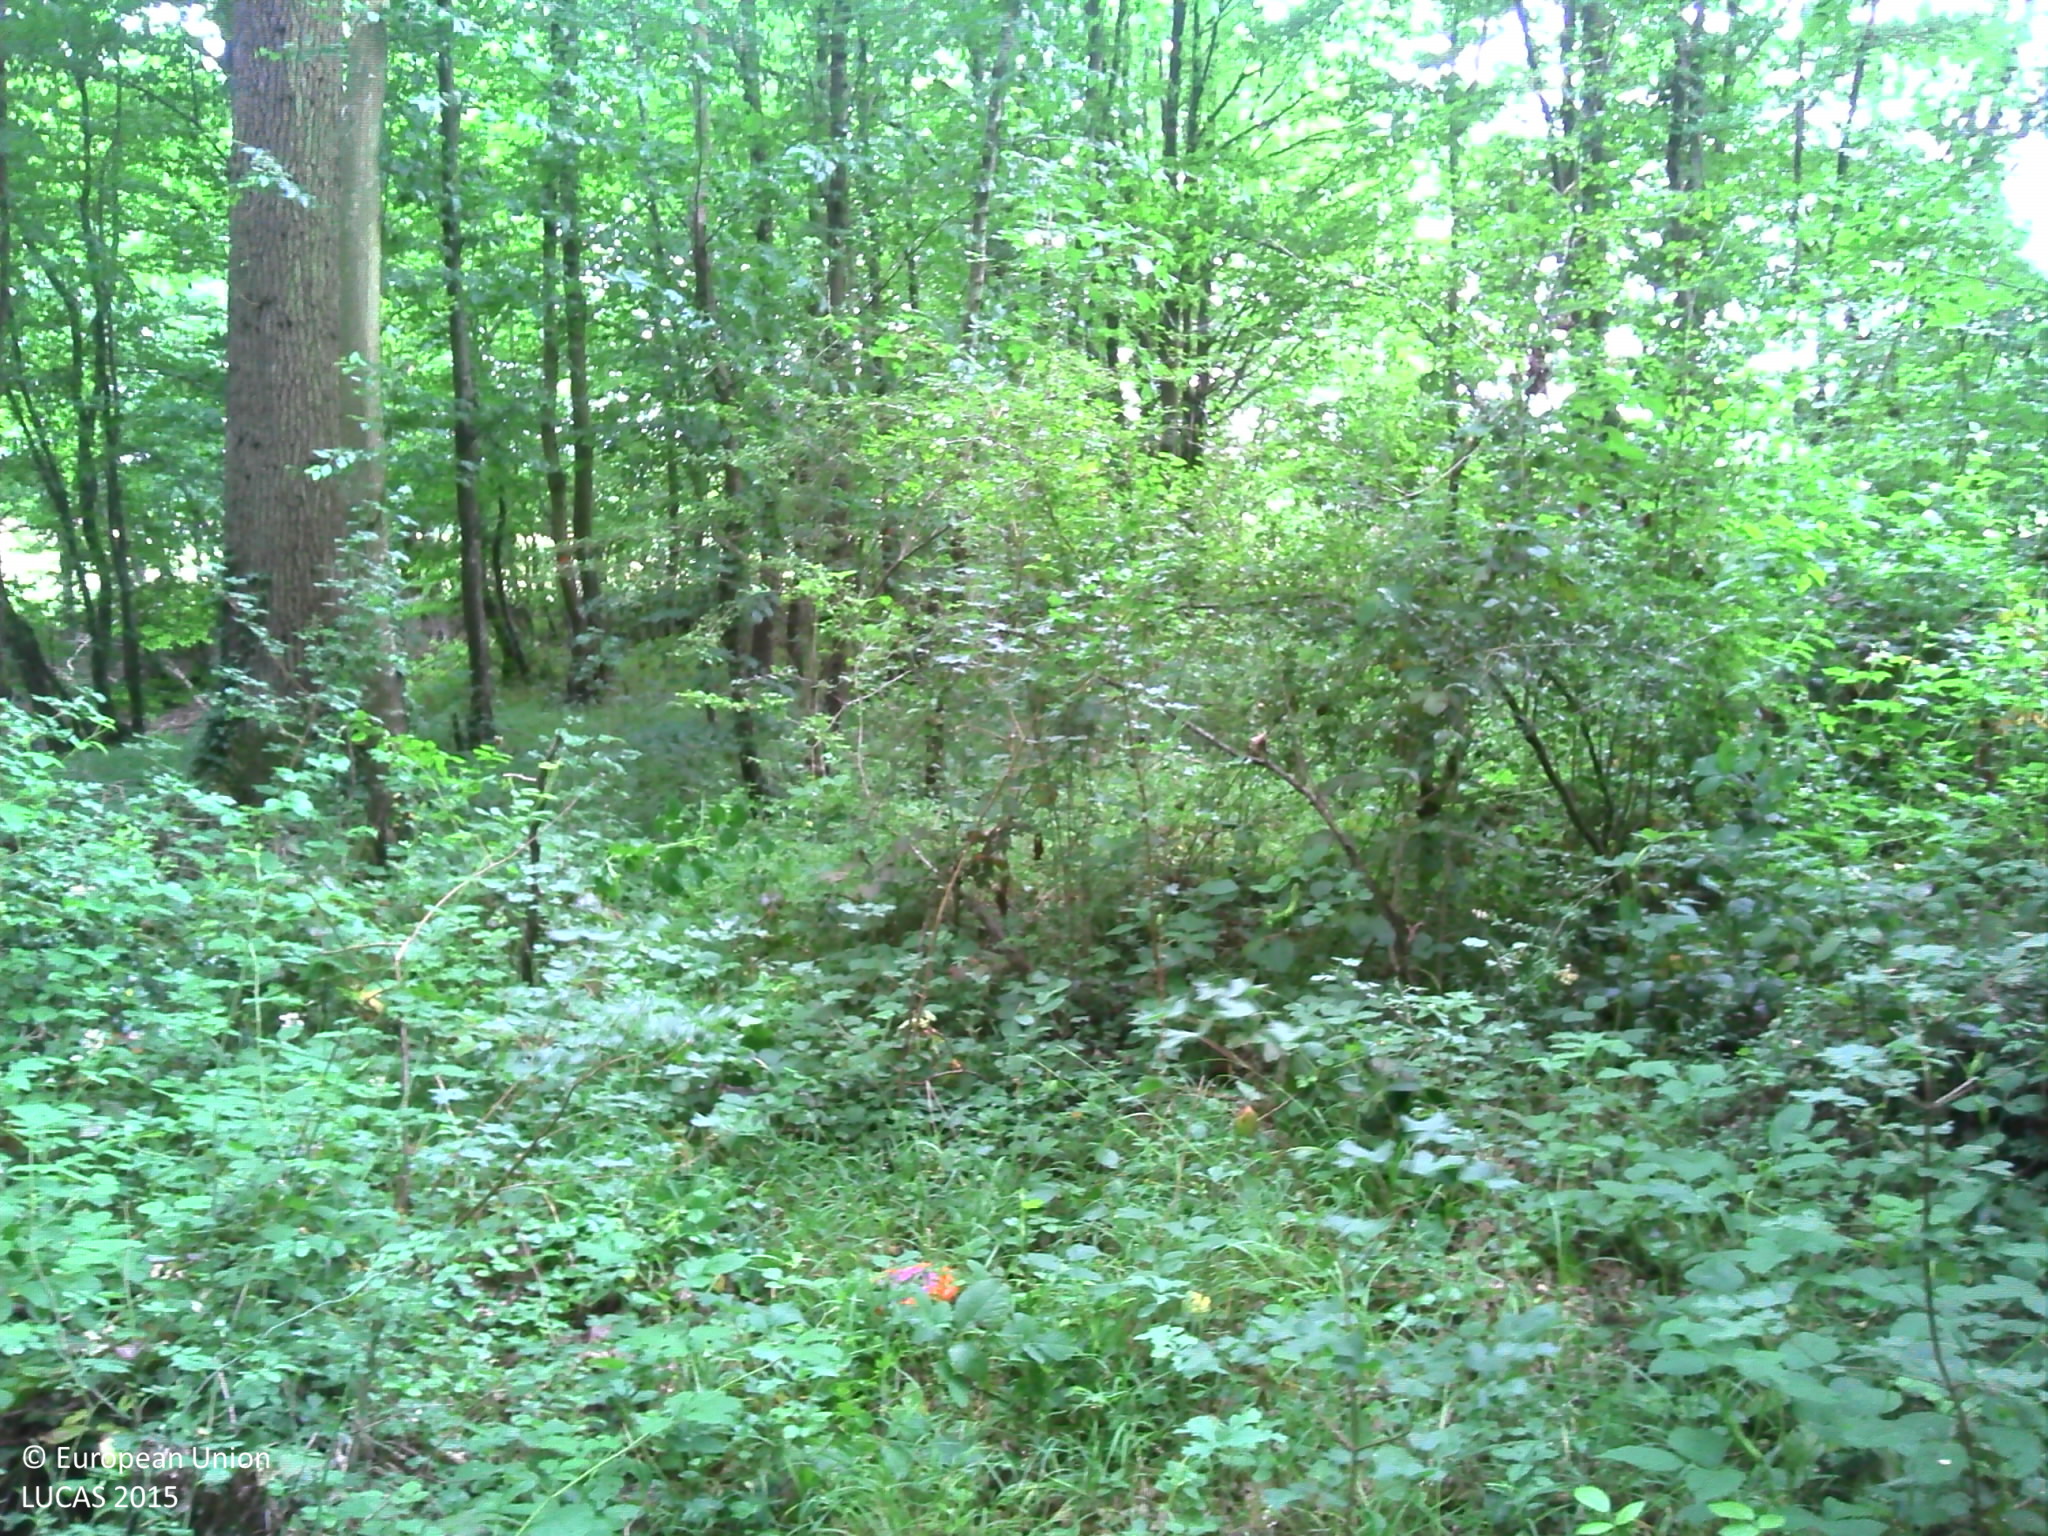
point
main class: Woodland
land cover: Broadleaved woodland
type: beech forest
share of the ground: > 75 %
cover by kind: broadleaved forest trees 65 %, herbaceous plants 20 %, shrubs 15 %
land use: Forestry
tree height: > 5 m
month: June
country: FR
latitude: 48.1177
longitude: 0.2620
